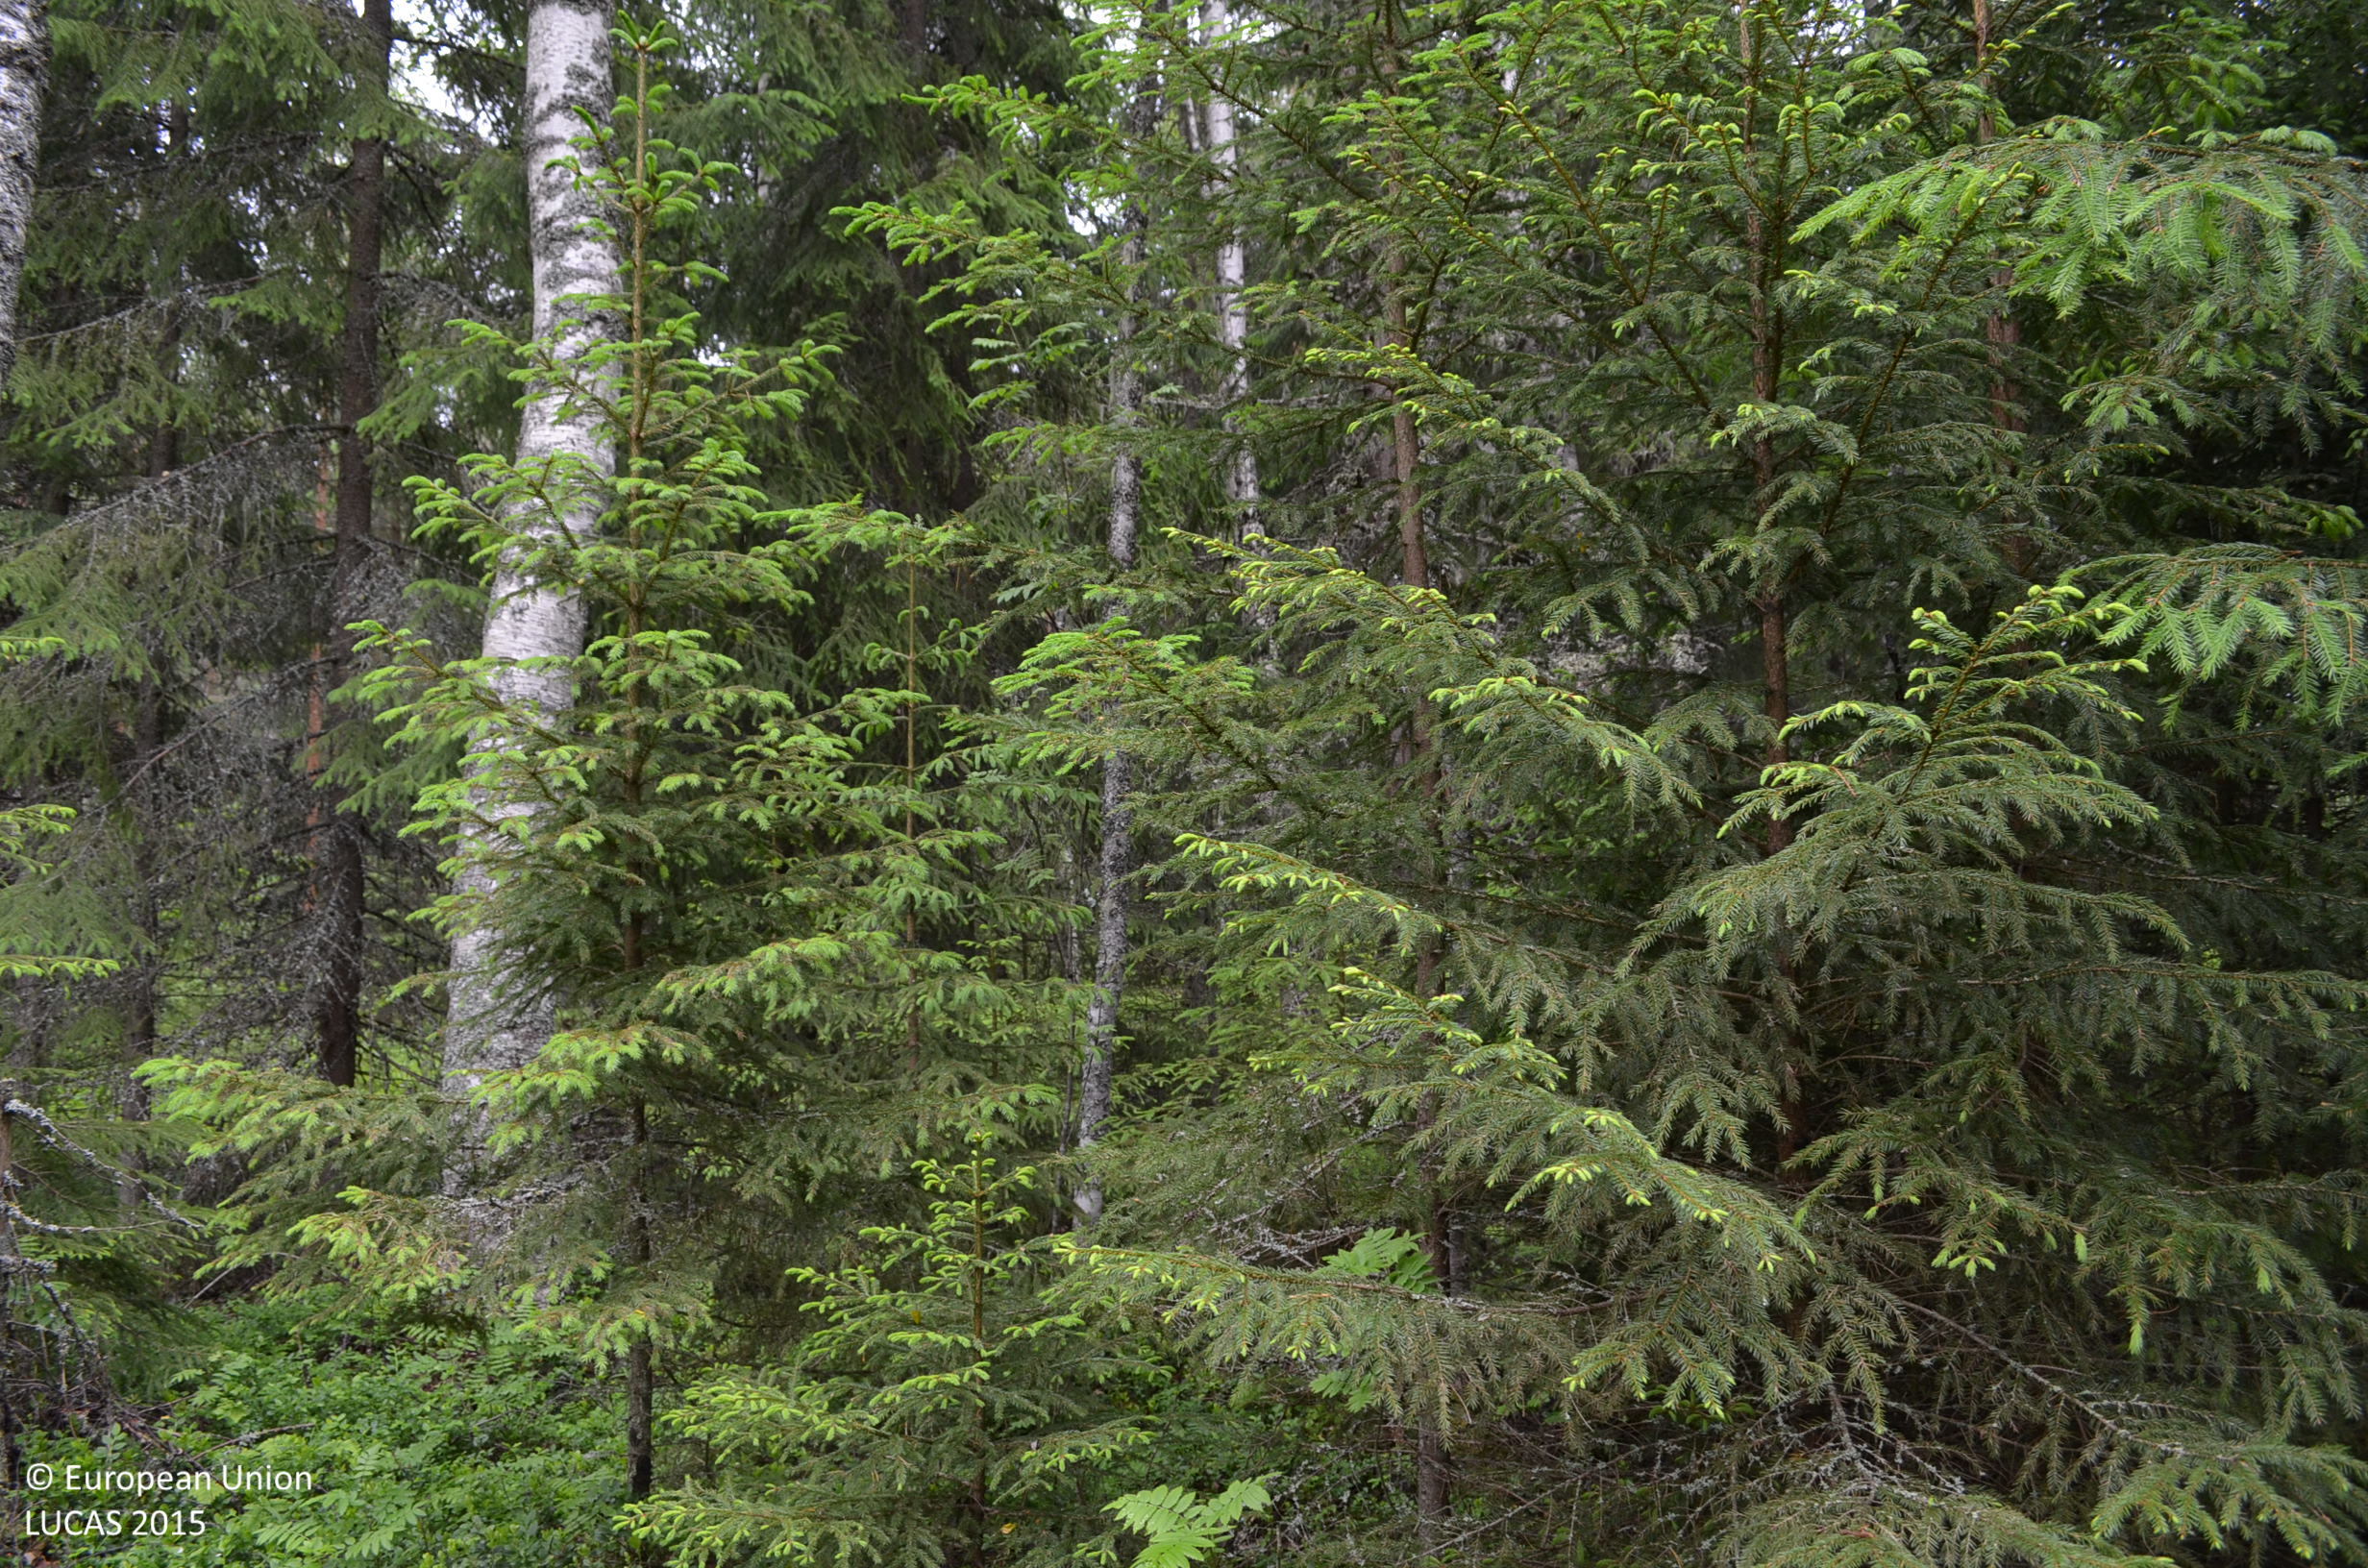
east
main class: Woodland
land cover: Other mixed woodland
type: boreal forest
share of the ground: > 75 %
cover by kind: broadleaved forest trees 45 %, coniferous forest trees 35 %, shrubs 20 %
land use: Forestry
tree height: > 5 m
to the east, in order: Other mixed woodland; Pine dominated mixed woodland; Ditches and canals; Pine dominated mixed woodland; Other mixed woodland
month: June
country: FI
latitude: 61.7104
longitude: 23.0647
